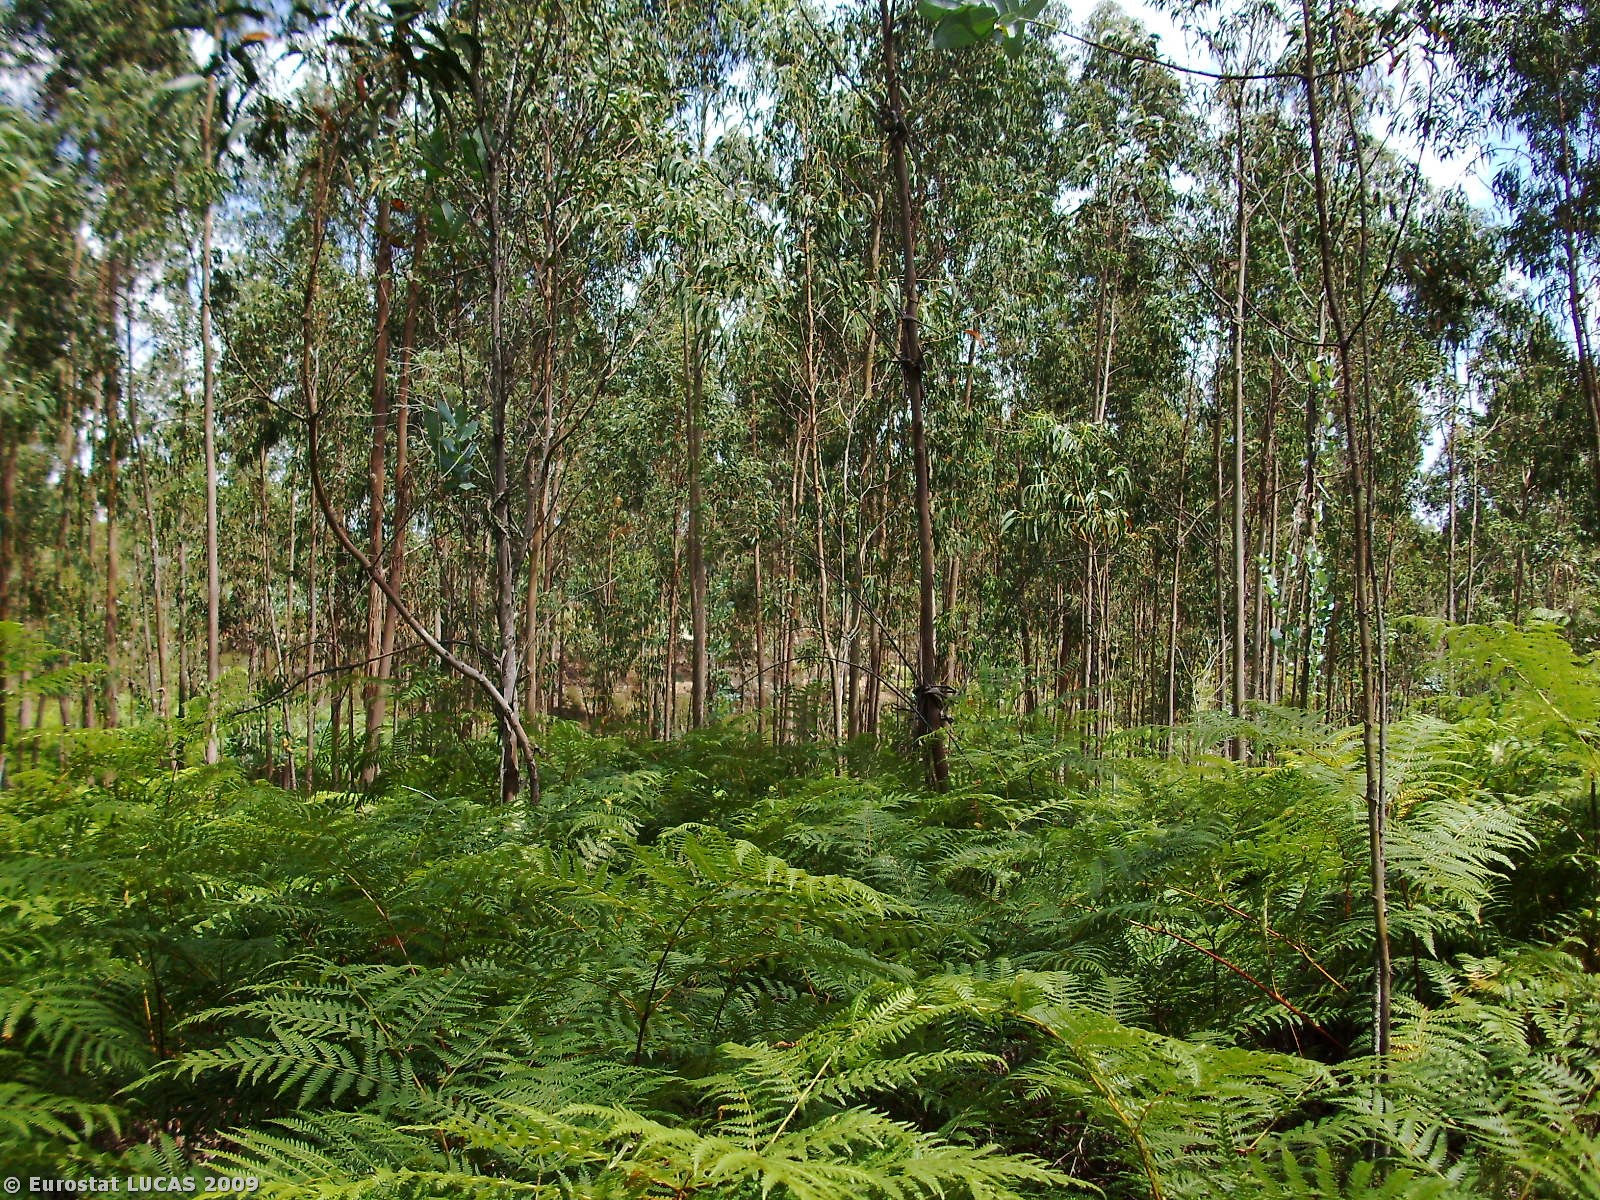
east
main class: Woodland
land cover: Broadleaved woodland
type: plantations and self-sown exotic forest
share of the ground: 10 - 25 %
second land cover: Shrubland with sparse tree cover
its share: > 75 %
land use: Forestry
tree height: > 5 m
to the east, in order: Broadleaved woodland; Shrubland with sparse tree cover; Broadleaved woodland; Tracks
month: July
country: PT
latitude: 39.7339
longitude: -8.8612
